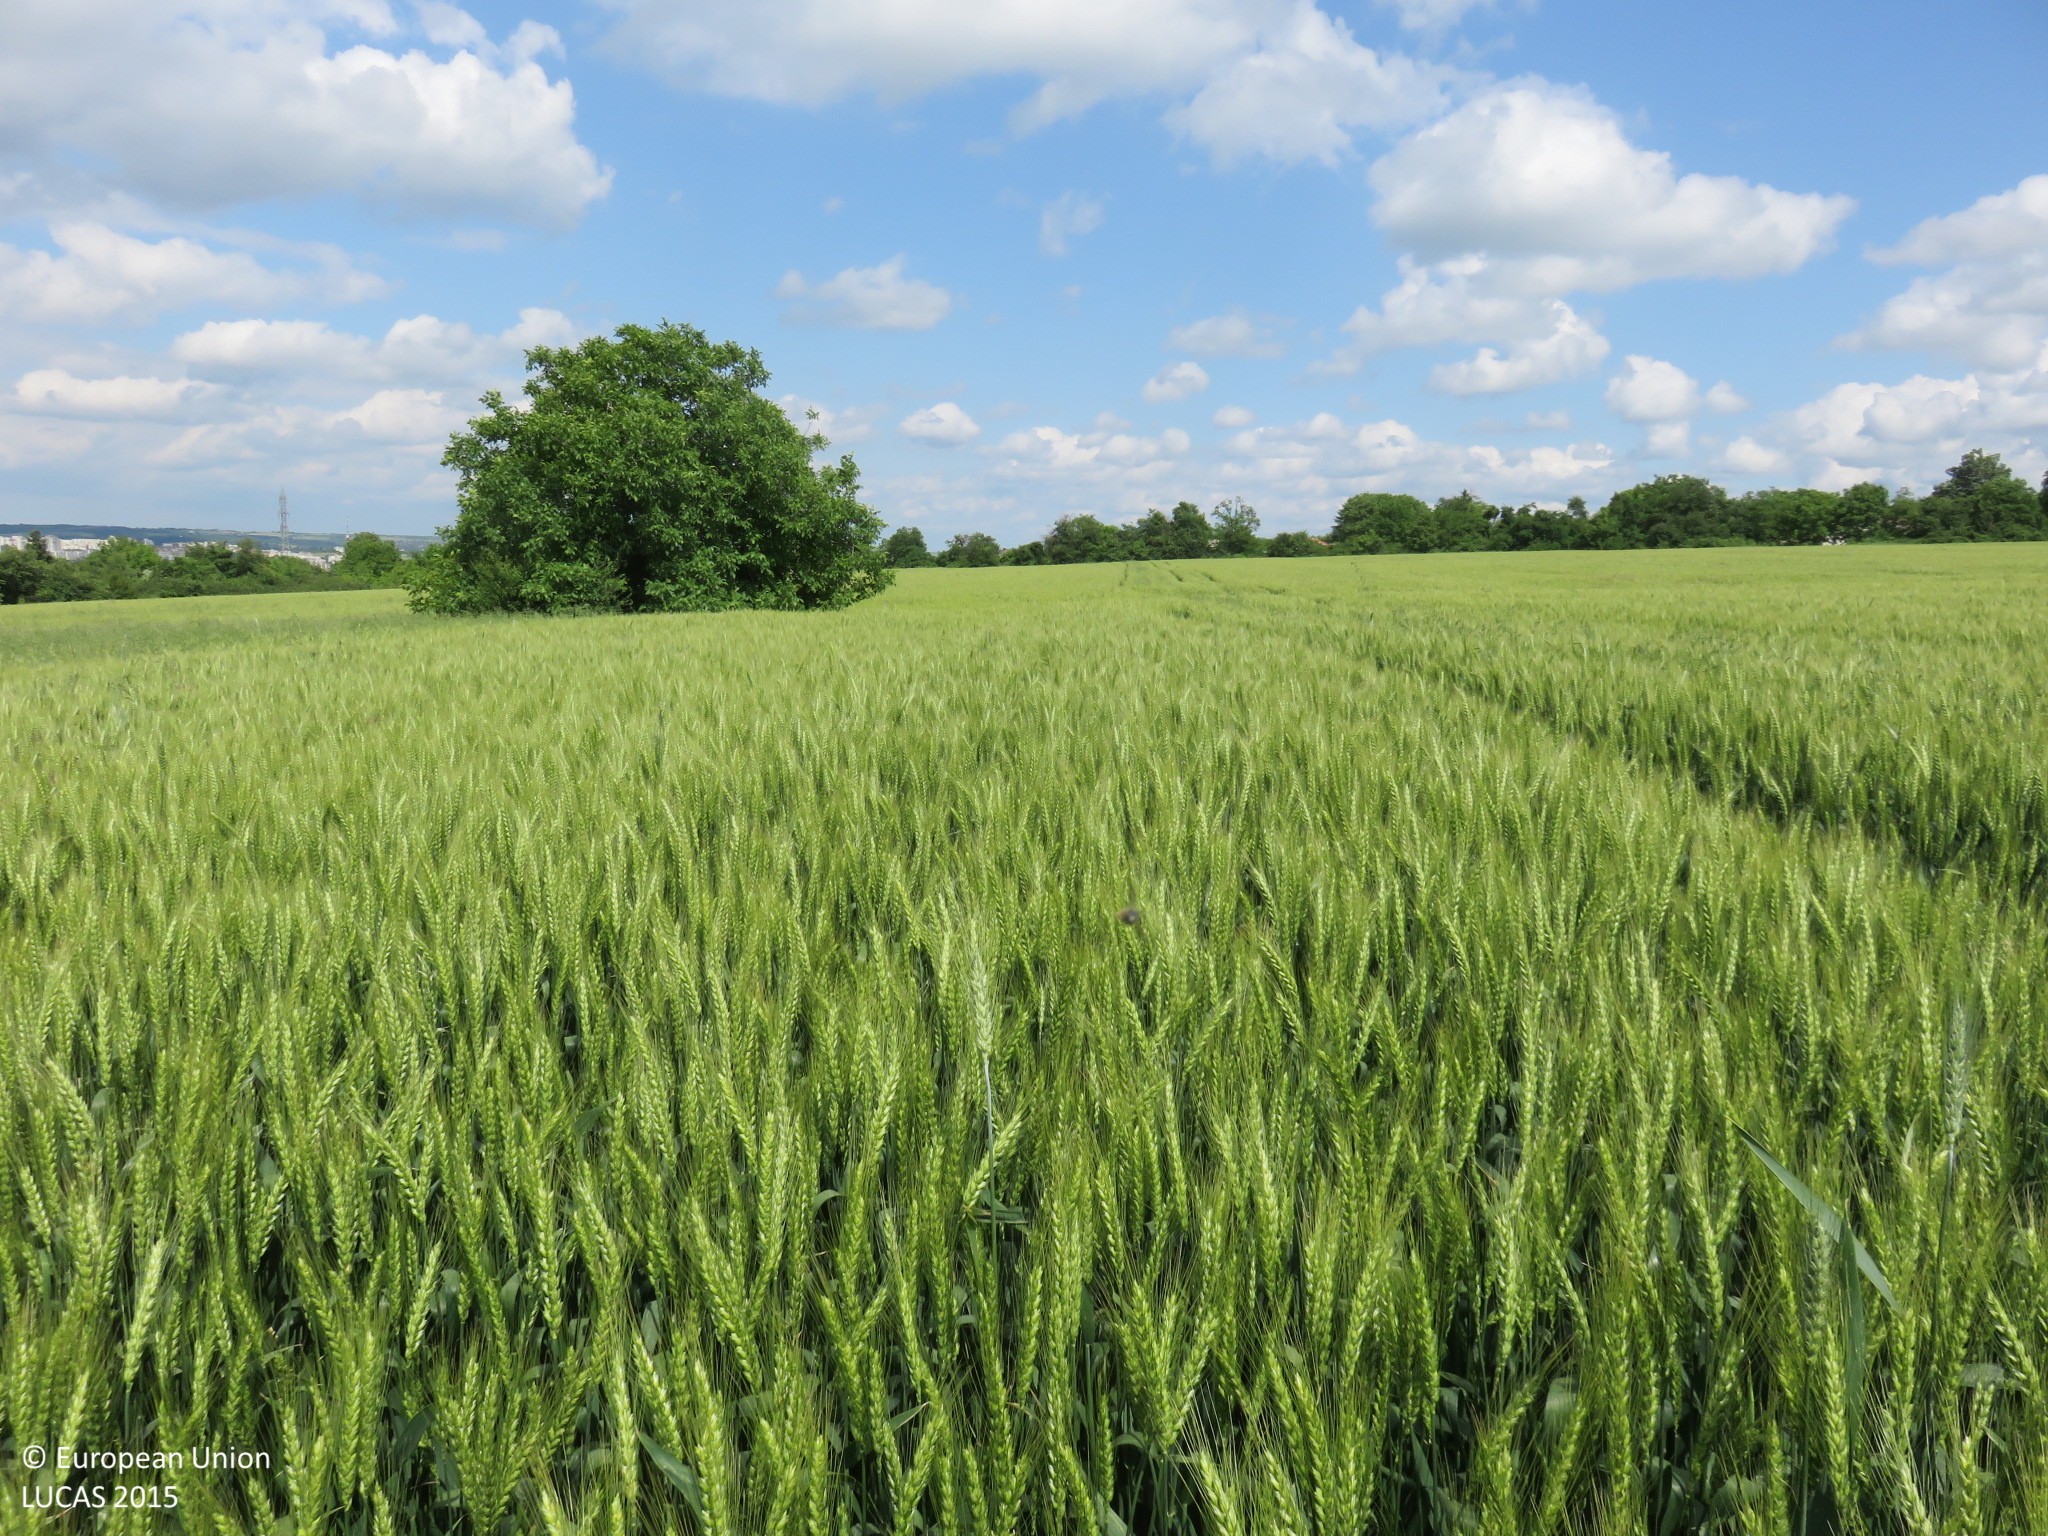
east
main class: Cropland
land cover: Common wheat
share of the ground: > 75 %
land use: Agriculture (excluding fallow land and kitchen gardens)
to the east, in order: Common wheat
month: May
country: BG
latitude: 43.3859
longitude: 24.5913
